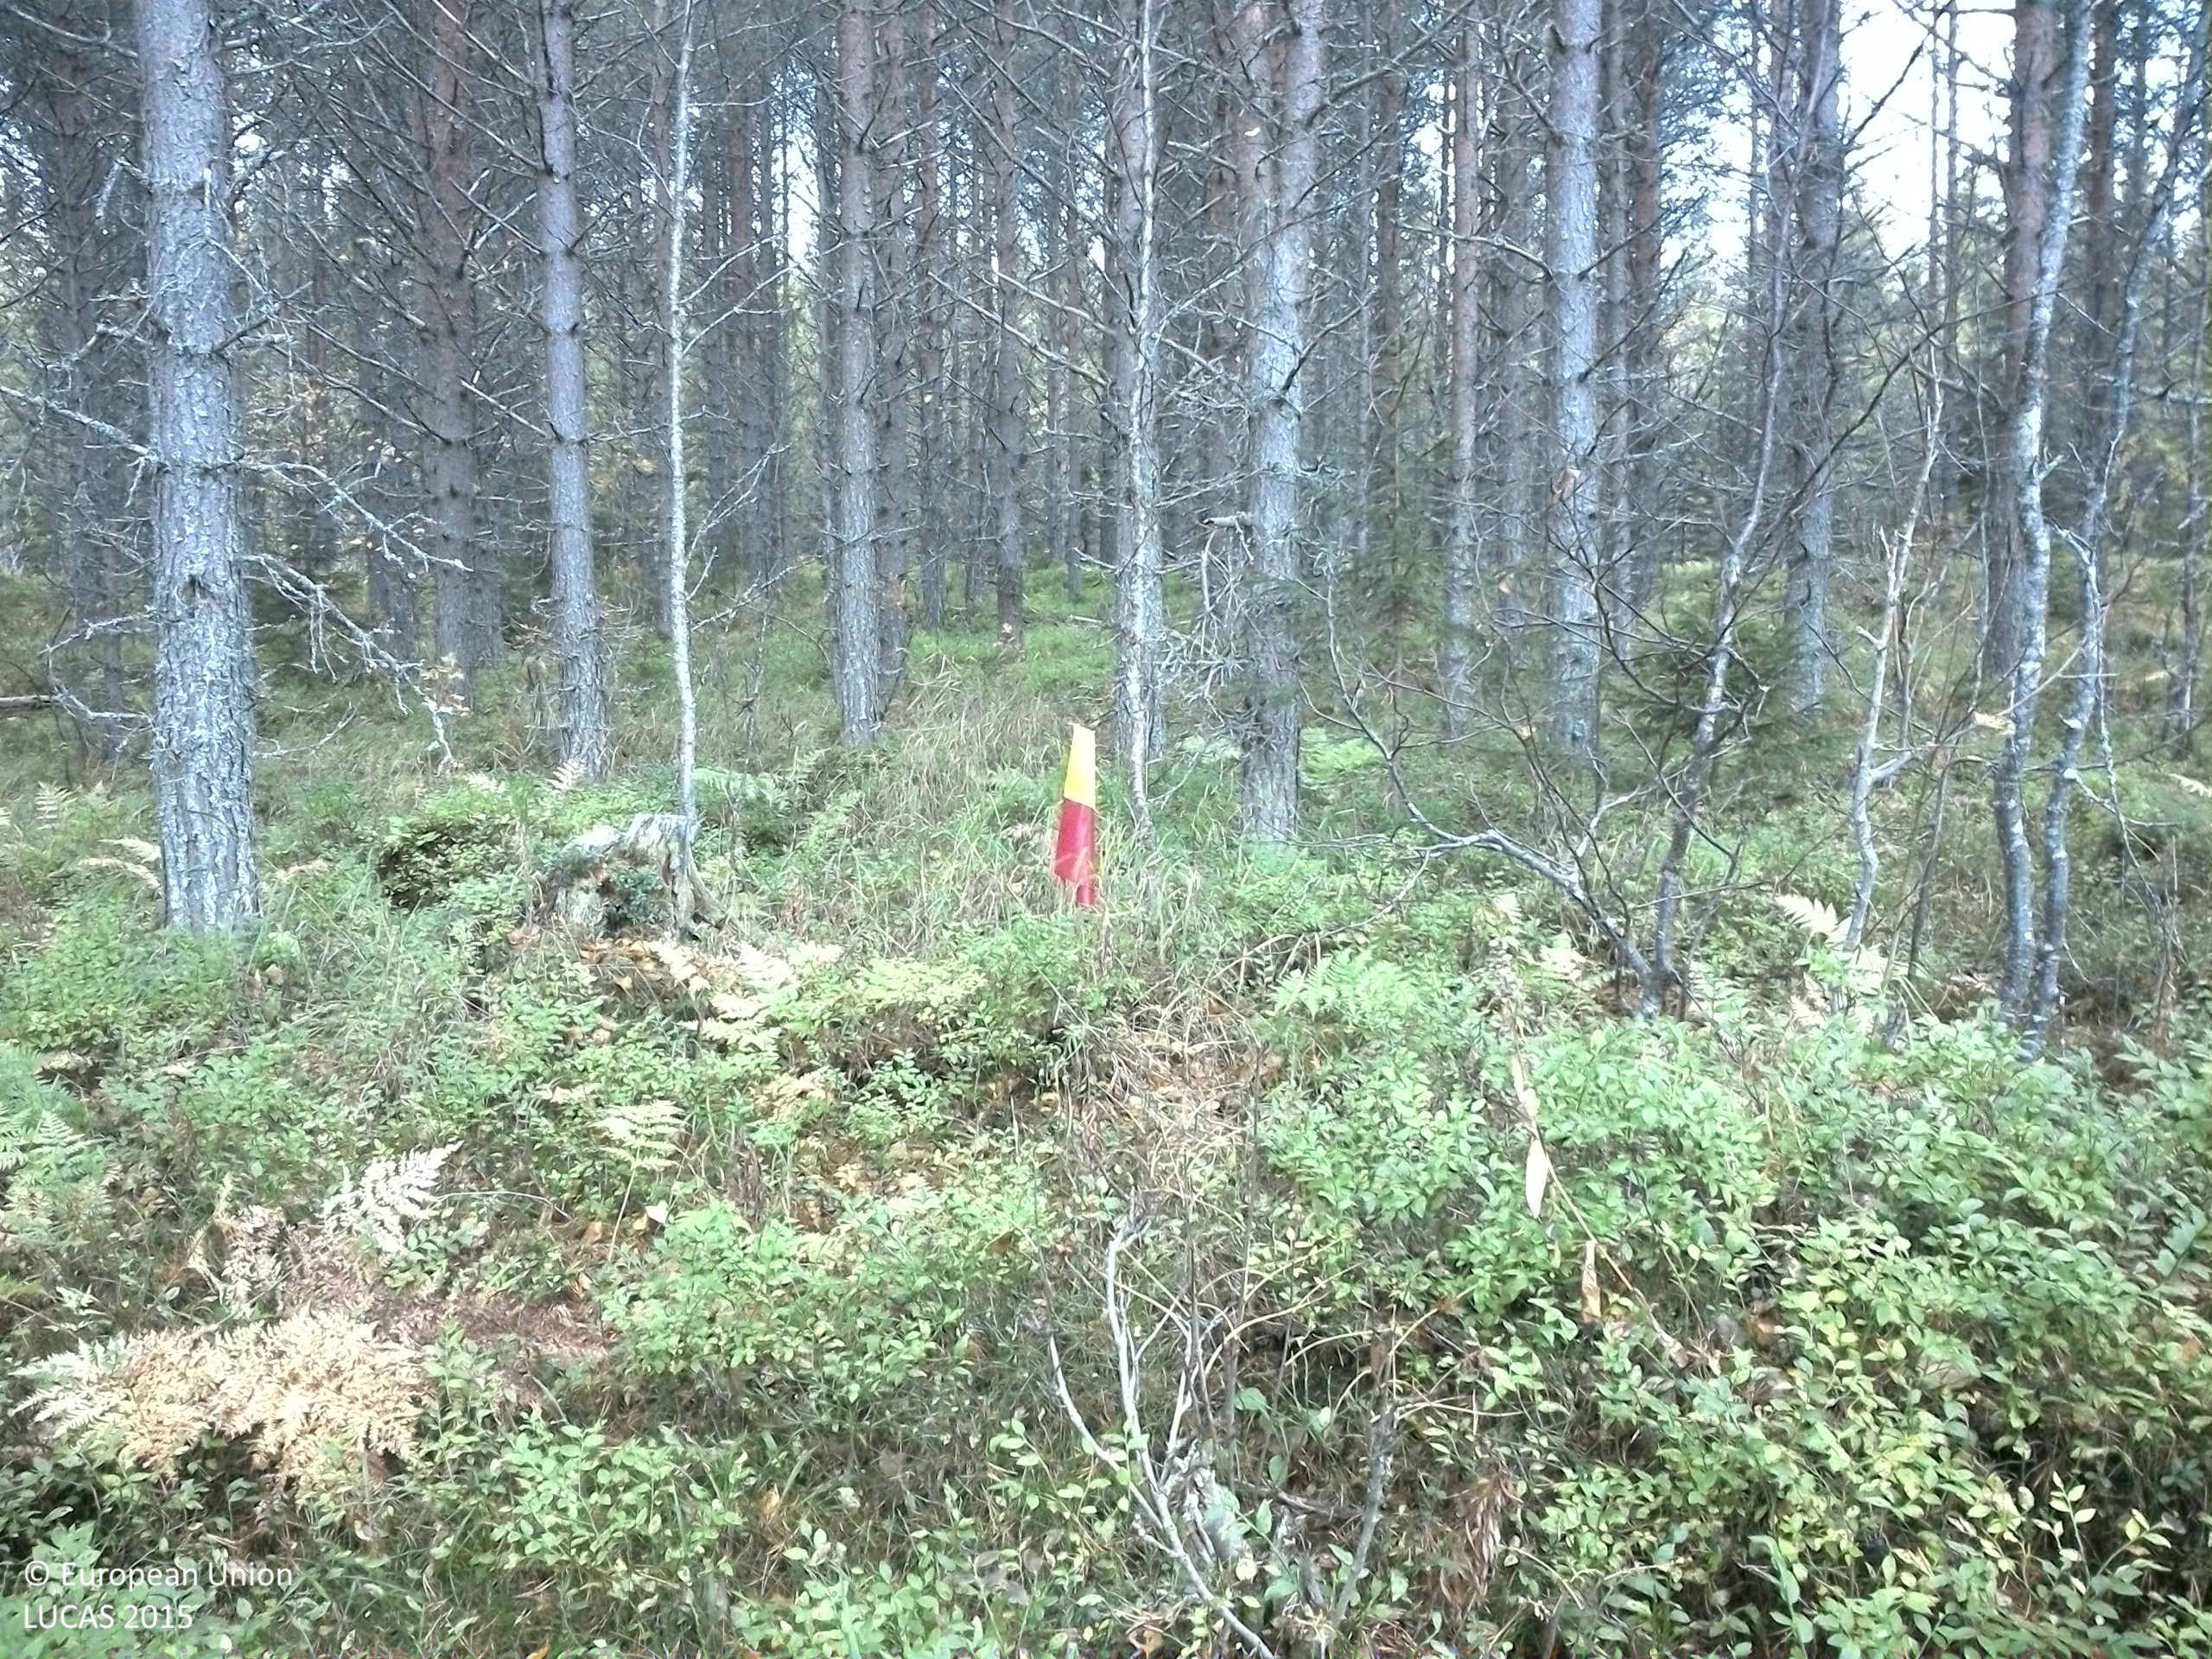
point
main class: Woodland
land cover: Pine dominated coniferous woodland
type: boreal forest
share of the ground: 50 - 75 %
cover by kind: coniferous forest trees 45 %, shrubs 25 %, broadleaved forest trees 10 %, herbaceous plants 10 %, lichens and mosses 10 %
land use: Forestry
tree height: > 5 m
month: October
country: SE
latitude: 64.2284
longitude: 16.0514
